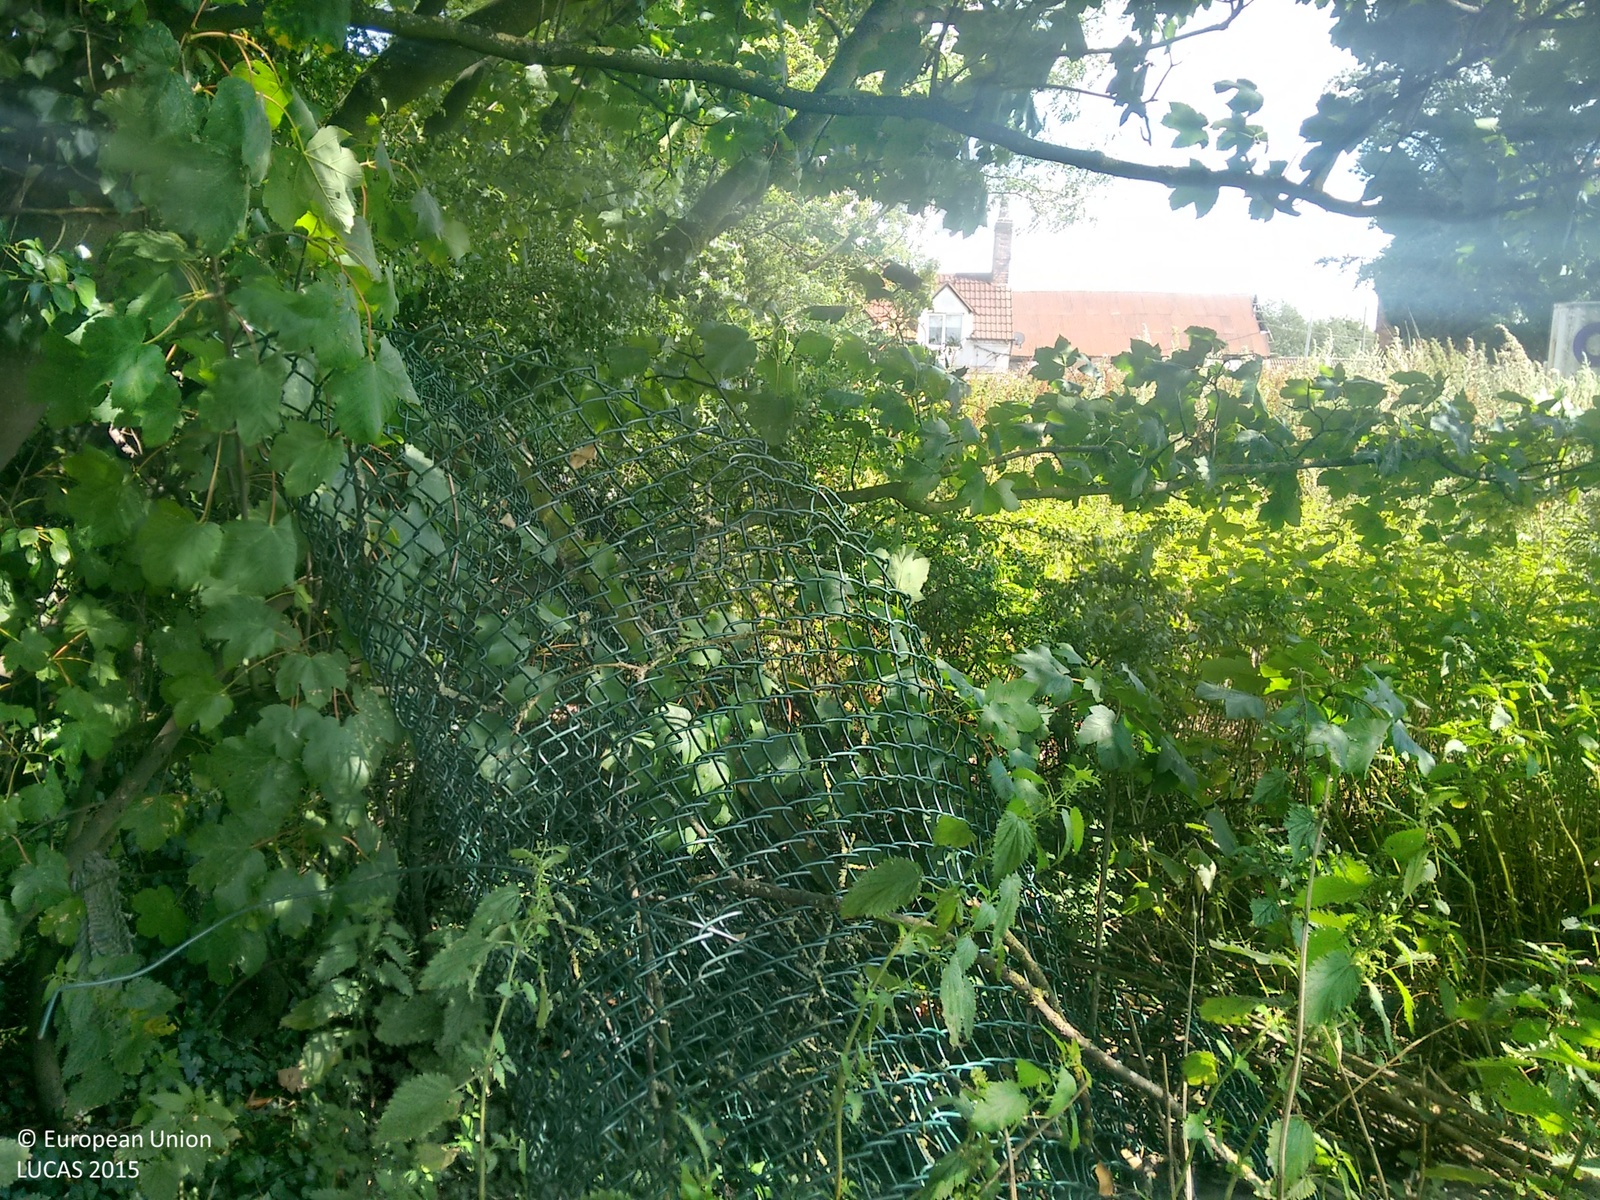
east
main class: Grassland
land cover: Grassland without tree/shrub cover
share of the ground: > 75 %
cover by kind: herbaceous plants 100 %
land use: Semi-natural and natural areas not in use
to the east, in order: Grassland without tree/shrub cover; Other bare soil; Artificial constructions in urban areas
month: July
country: GB
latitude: 52.4457
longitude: -1.7511
